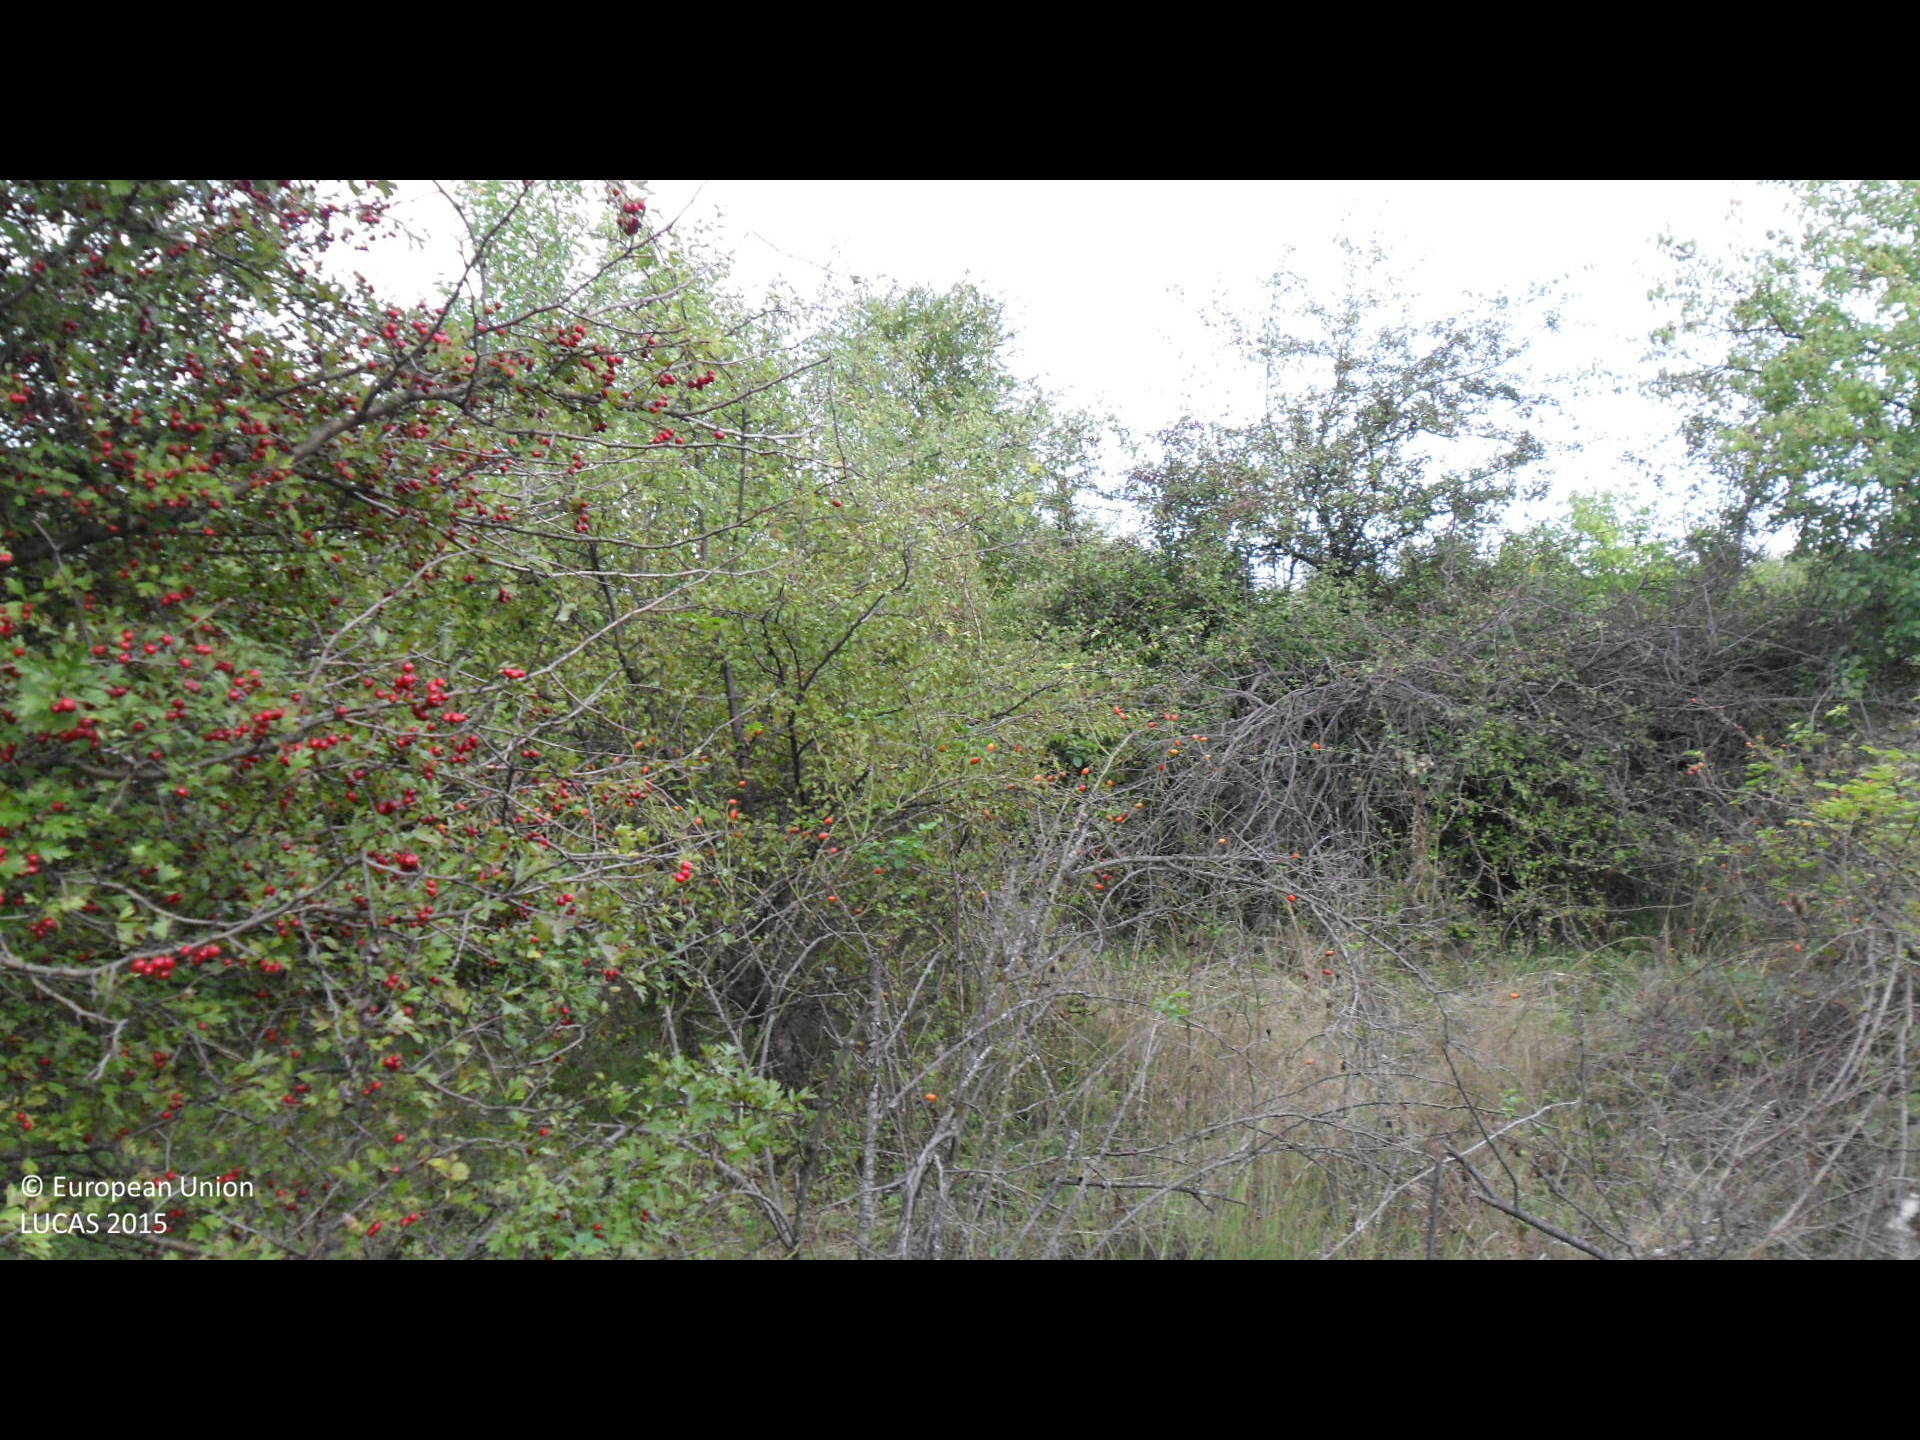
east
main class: Shrubland
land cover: Shrubland with sparse tree cover
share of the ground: > 75 %
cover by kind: shrubs 95 %, broadleaved forest trees 5 %
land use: Agriculture (excluding fallow land and kitchen gardens)
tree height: < 5 m
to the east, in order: Shrubland with sparse tree cover; Grassland with sparse tree/shrub cover; Tracks; Single bushes/trees; Grassland without tree/shrub cover; Broadleaved woodland; Spontaneously vegetated surfaces; Tracks
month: October
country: BG
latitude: 43.0824
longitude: 26.2207
